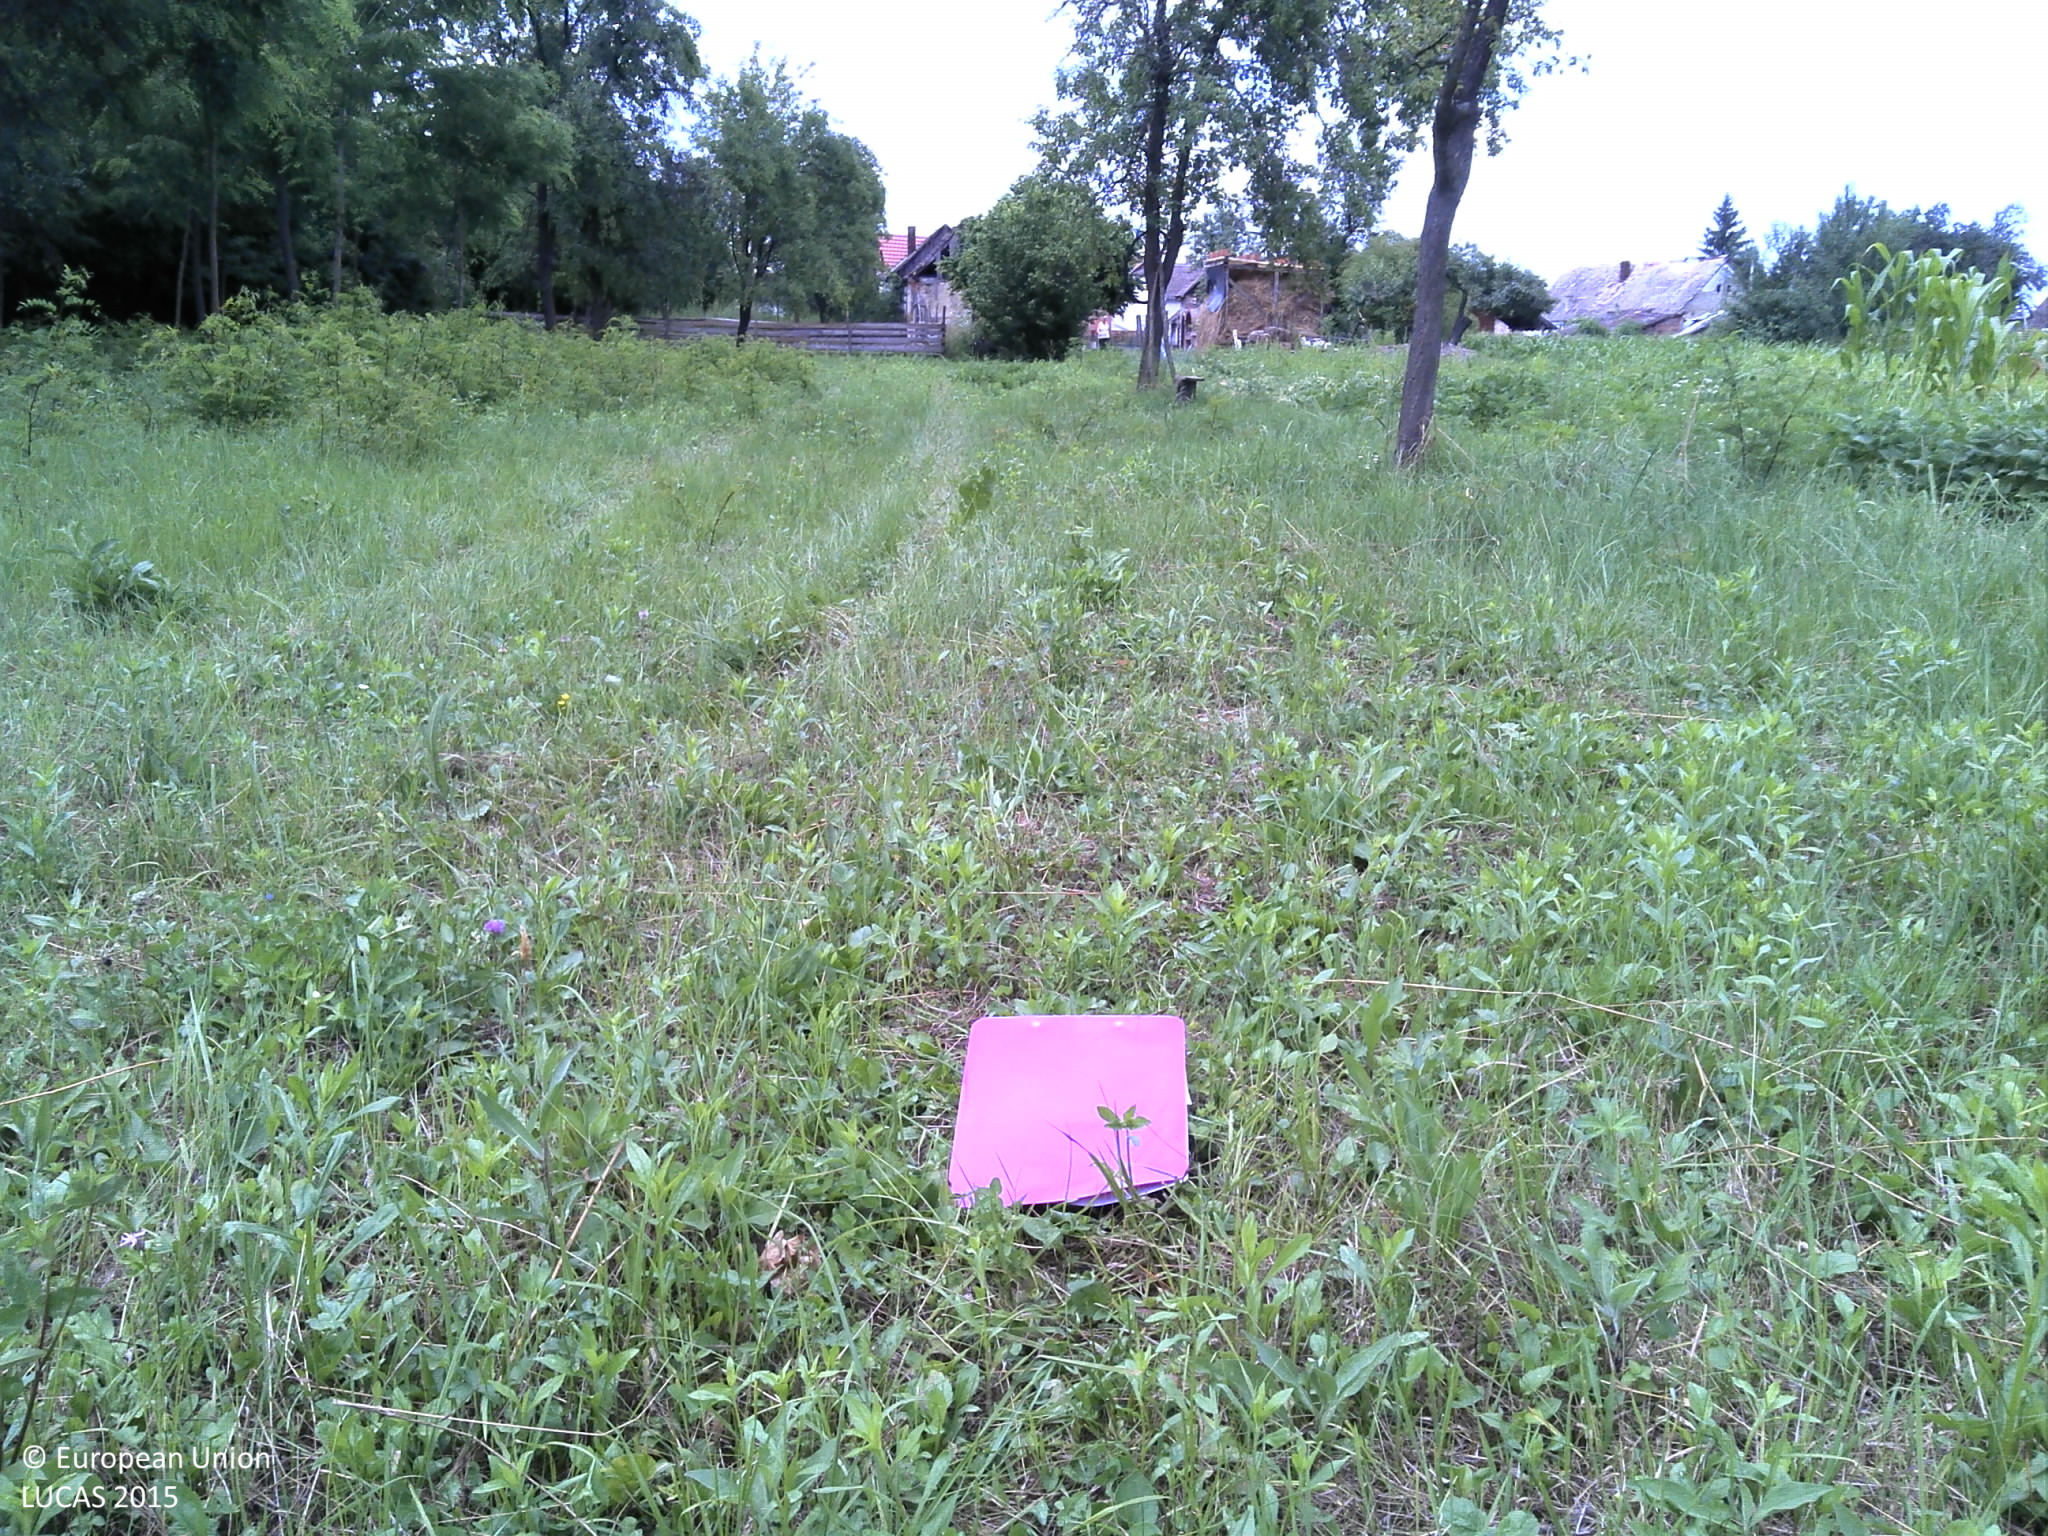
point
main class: Grassland
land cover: Grassland with sparse tree/shrub cover
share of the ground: > 75 %
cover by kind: herbaceous plants 90 %, broadleaved forest trees 5 %, shrubs 5 %
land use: Semi-natural and natural areas not in use
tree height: < 5 m
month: June
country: HR
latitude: 45.6912
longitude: 18.2111
